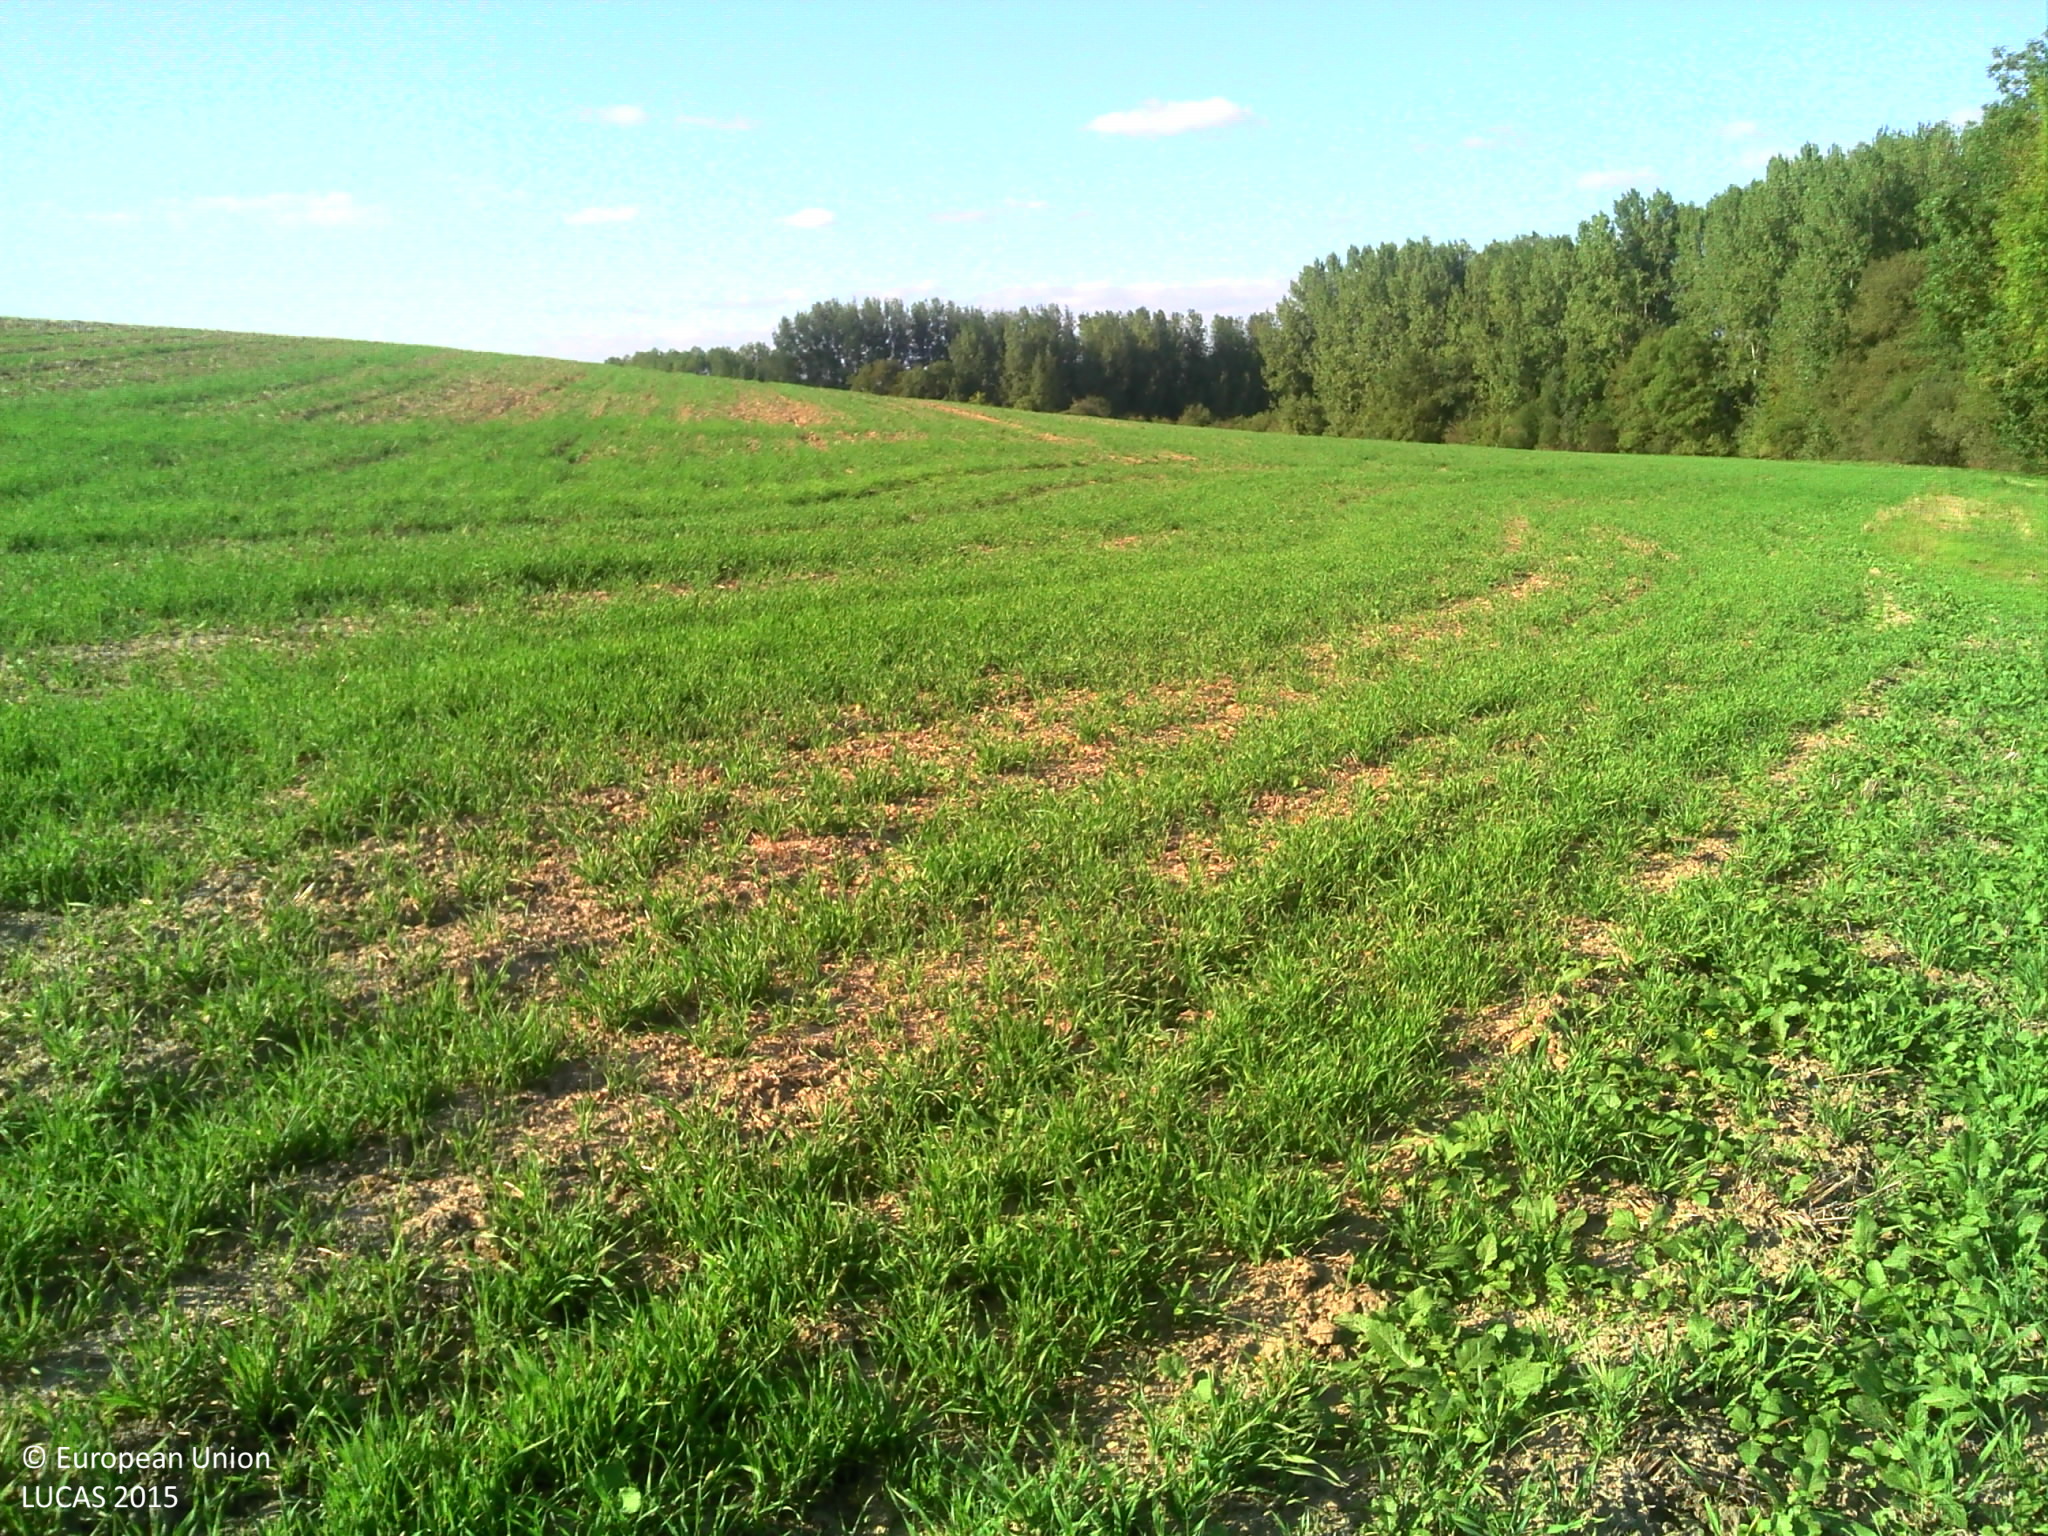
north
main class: Grassland
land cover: Grassland without tree/shrub cover
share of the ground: > 75 %
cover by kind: herbaceous plants 95 %, unconsolidated bare surface 5 %
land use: Agriculture (excluding fallow land and kitchen gardens)
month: September
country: FR
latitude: 47.0641
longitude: 1.5215
